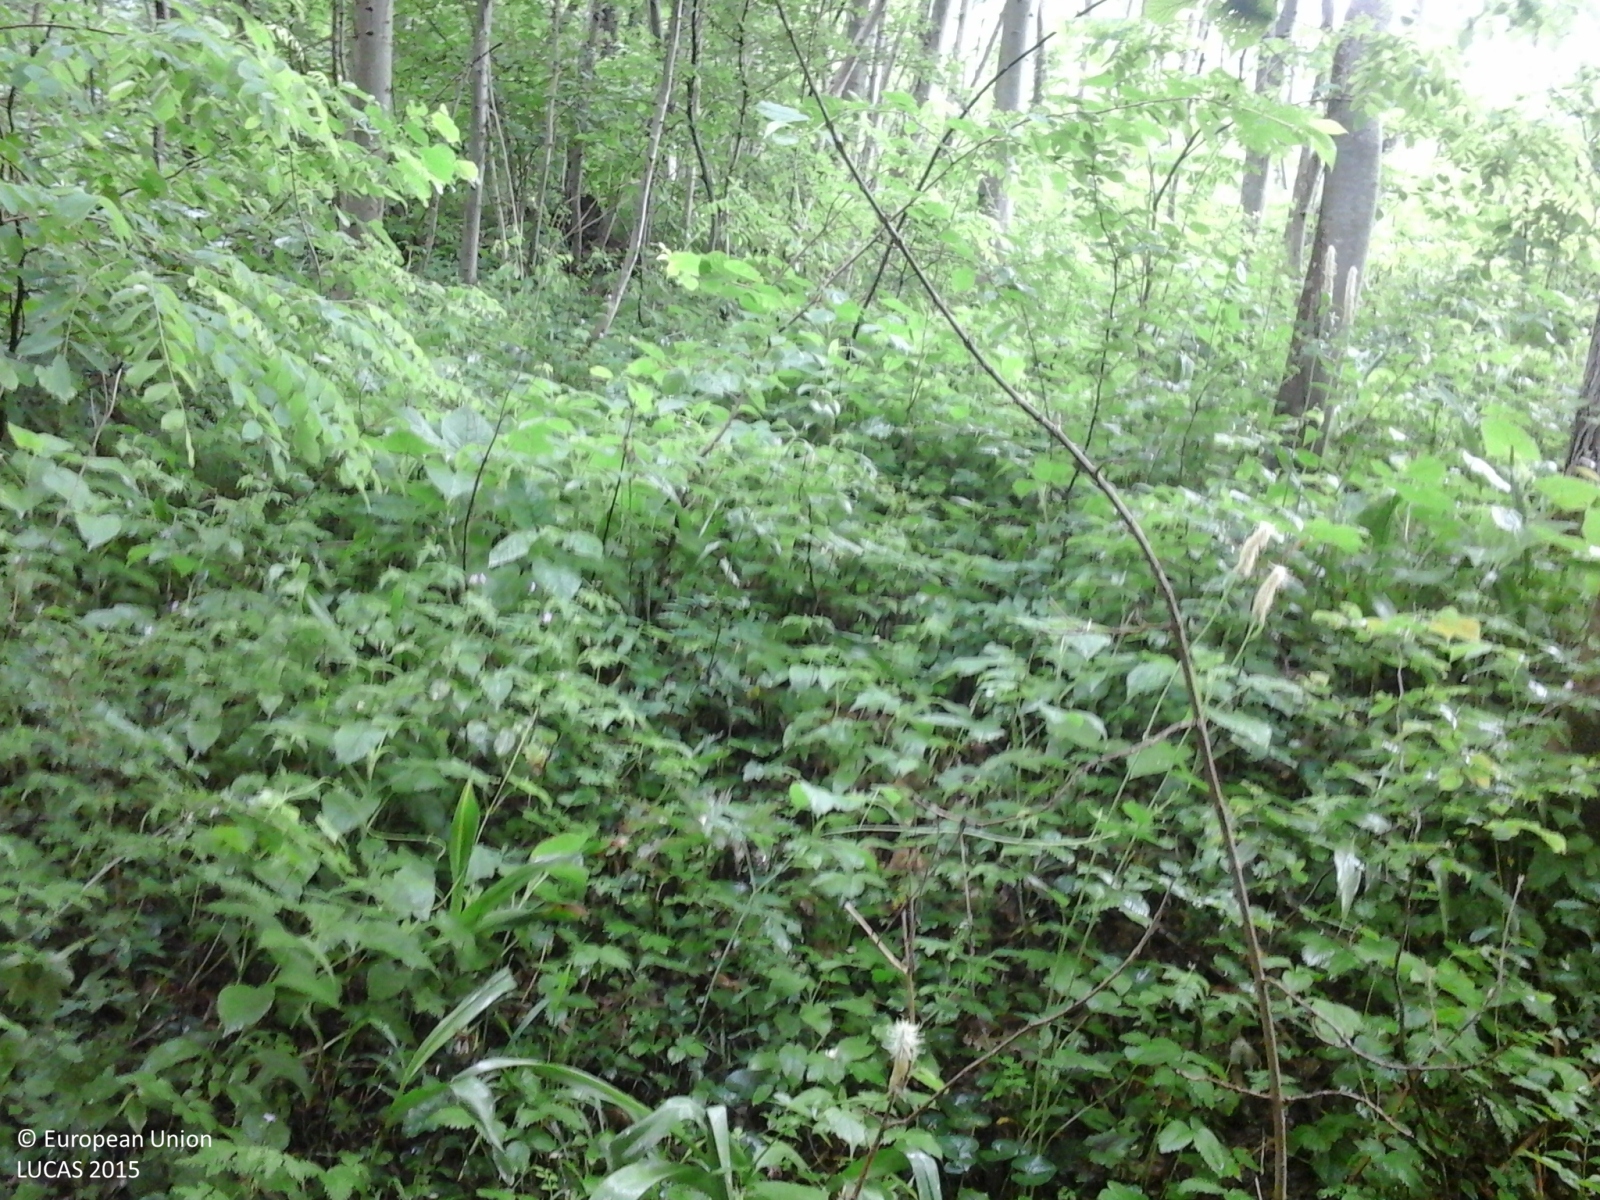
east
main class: Woodland
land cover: Broadleaved woodland
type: thermophilous deciduous forest
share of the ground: > 75 %
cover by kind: broadleaved forest trees 100 %
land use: Semi-natural and natural areas not in use
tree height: > 5 m
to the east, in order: Broadleaved woodland; Paved roads, cycling and walking lanes; Grassland without tree/shrub cover; Paved roads, cycling and walking lanes; Fences; Grassland without tree/shrub cover; Broadleaved woodland; Fences; Grassland without tree/shrub cover; Fences; Broadleaved woodland
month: June
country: IT
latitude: 46.1268
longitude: 12.3654
